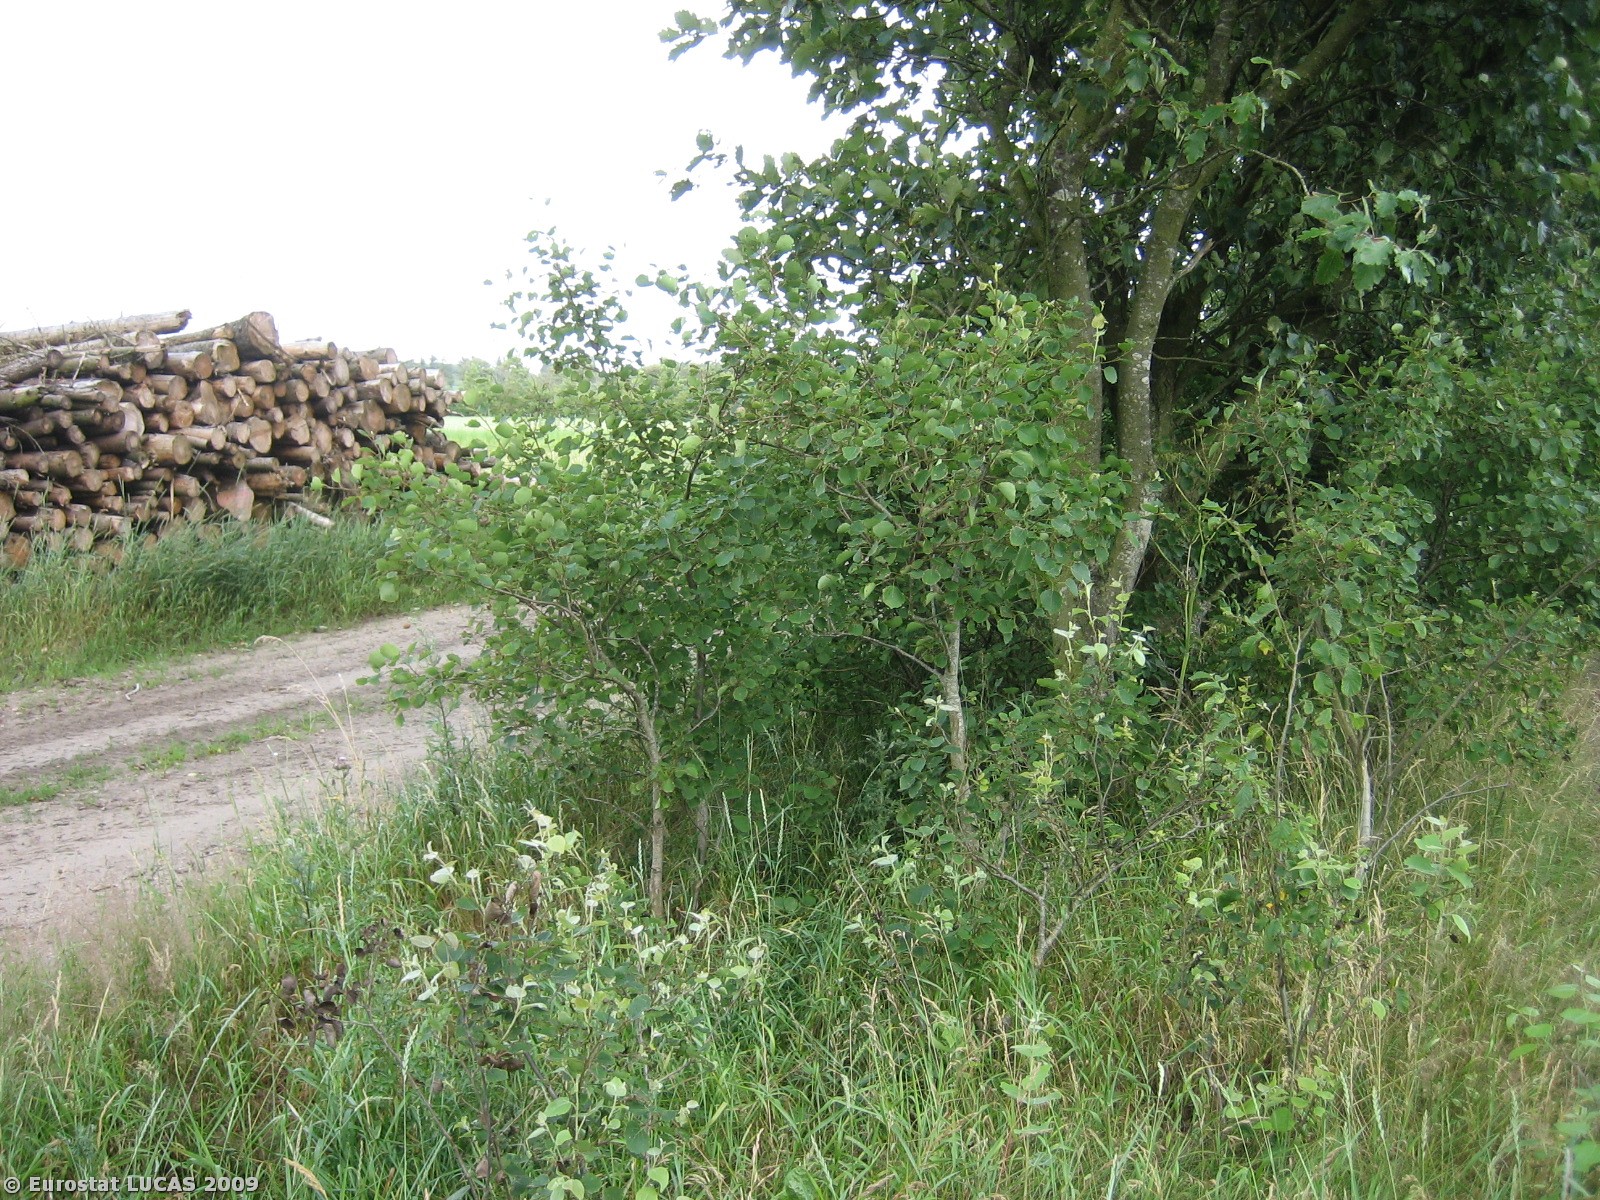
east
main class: Cropland
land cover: Barley
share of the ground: 25 - 50 %
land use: Agriculture (excluding fallow land and kitchen gardens)
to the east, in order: Barley; Grass margins; Tracks; Grass margins; Lines of trees; Maize; Broadleaved woodland; Maize
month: July
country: DK
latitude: 55.7107
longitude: 8.4258
